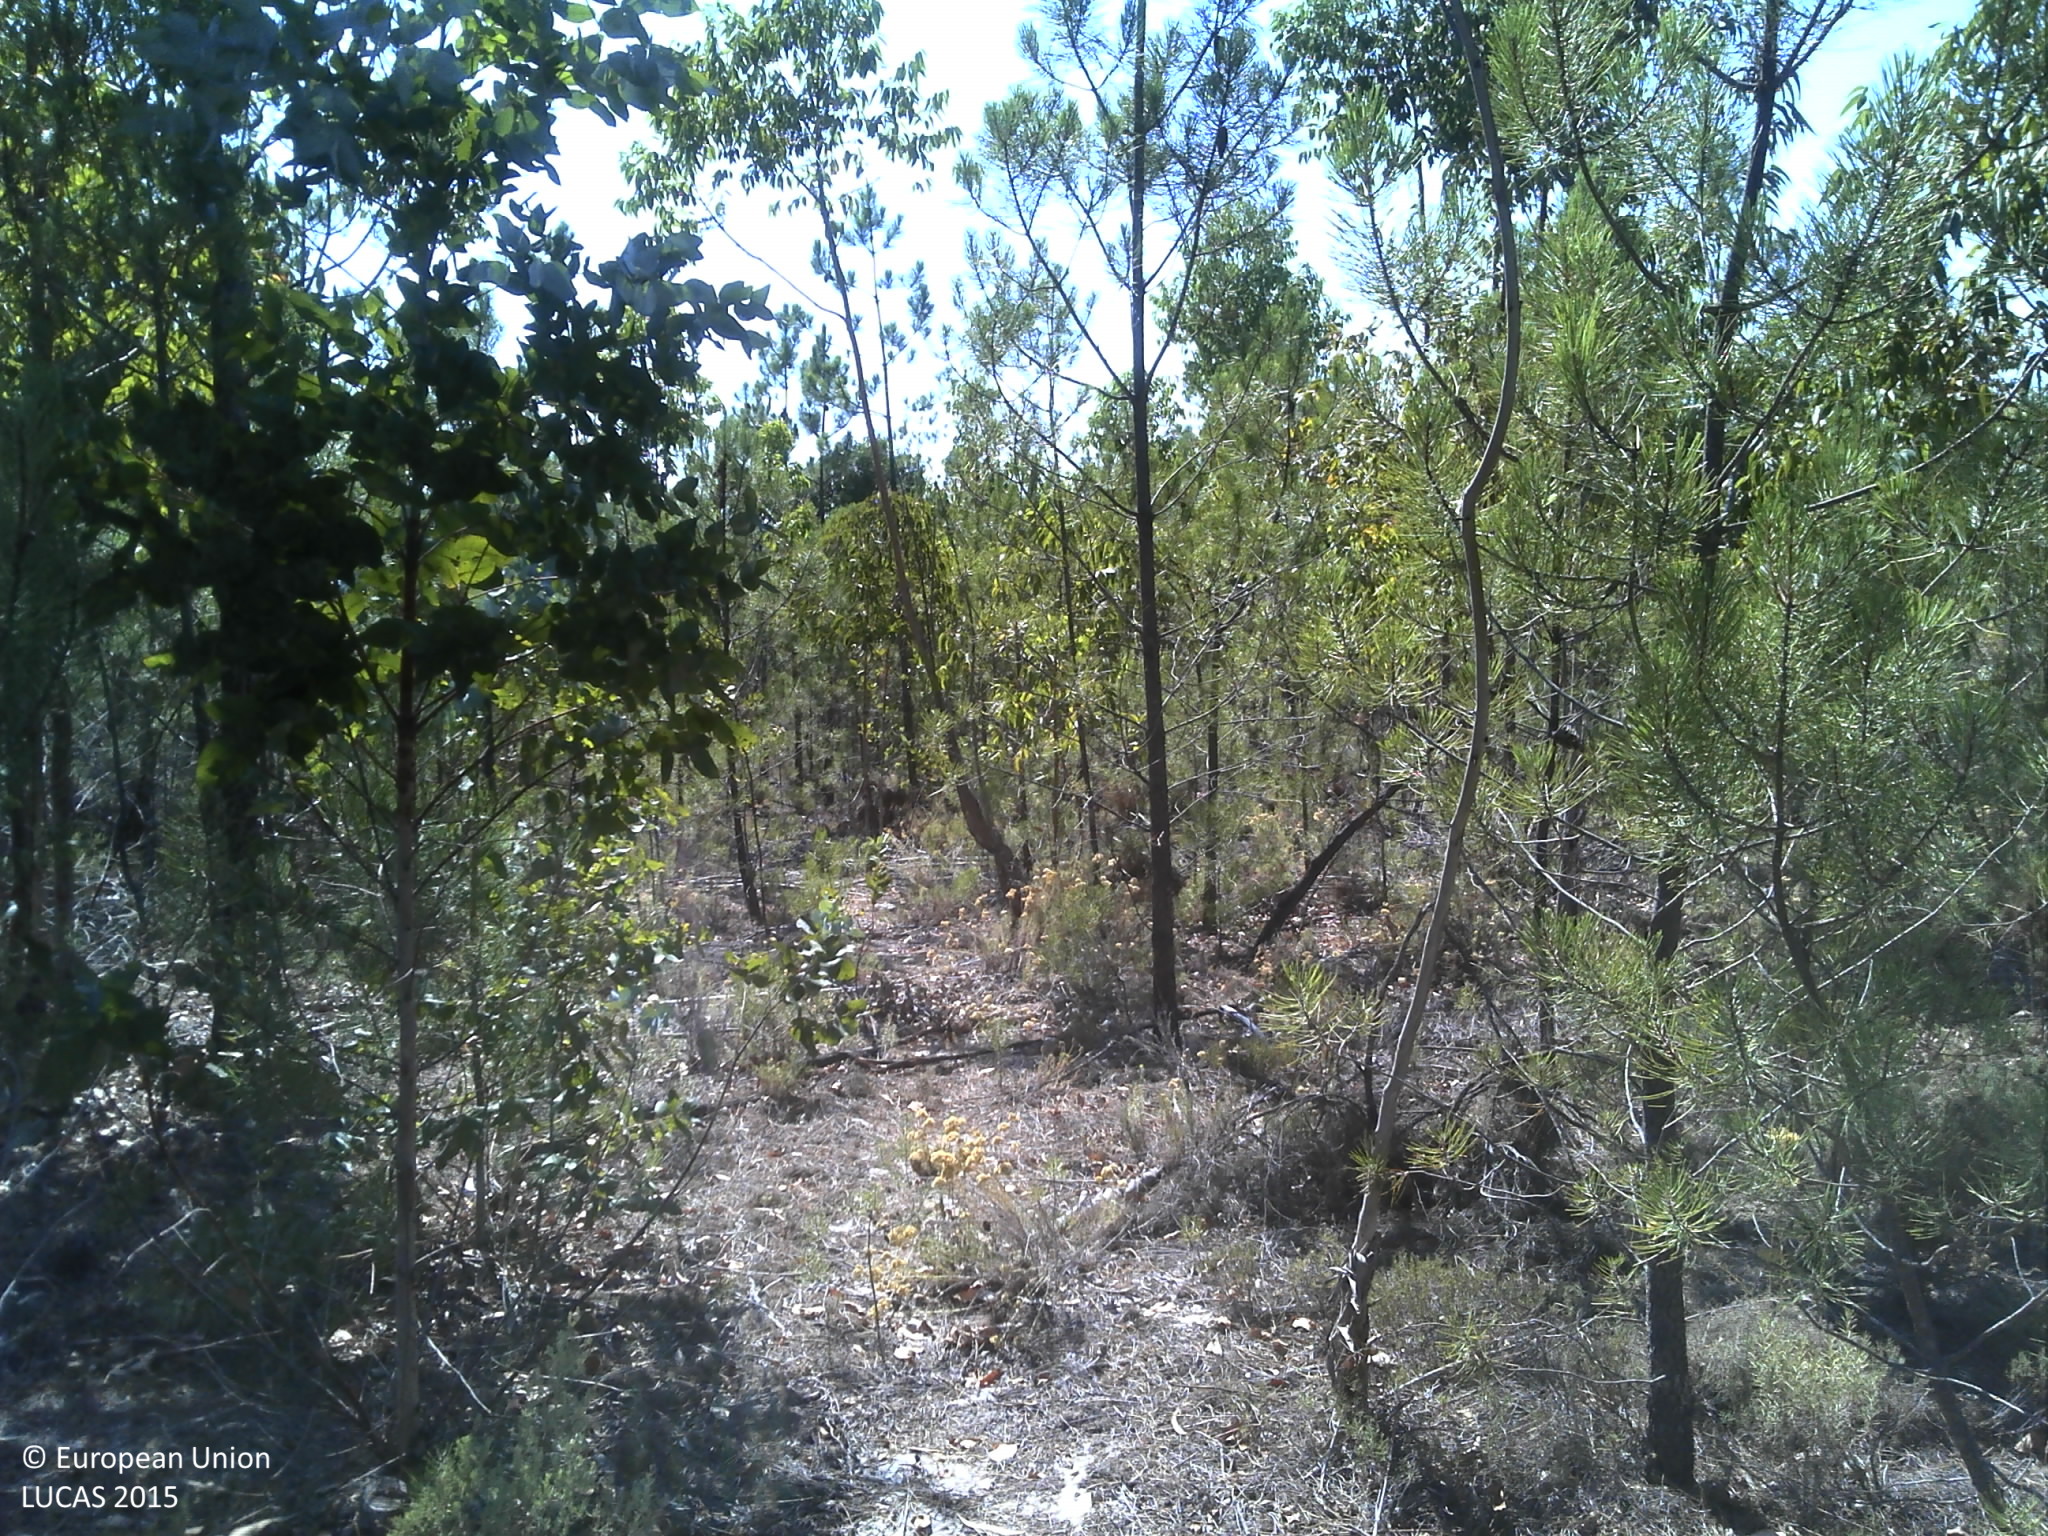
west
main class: Woodland
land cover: Broadleaved woodland
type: exotic forest
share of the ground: 25 - 50 %
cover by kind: broadleaved forest trees 40 %, unconsolidated bare surface 35 %, shrubs 10 %, herbaceous plants 10 %, coniferous forest trees 5 %
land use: Forestry
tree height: > 5 m
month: July
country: PT
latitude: 38.3108
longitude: -8.6607
